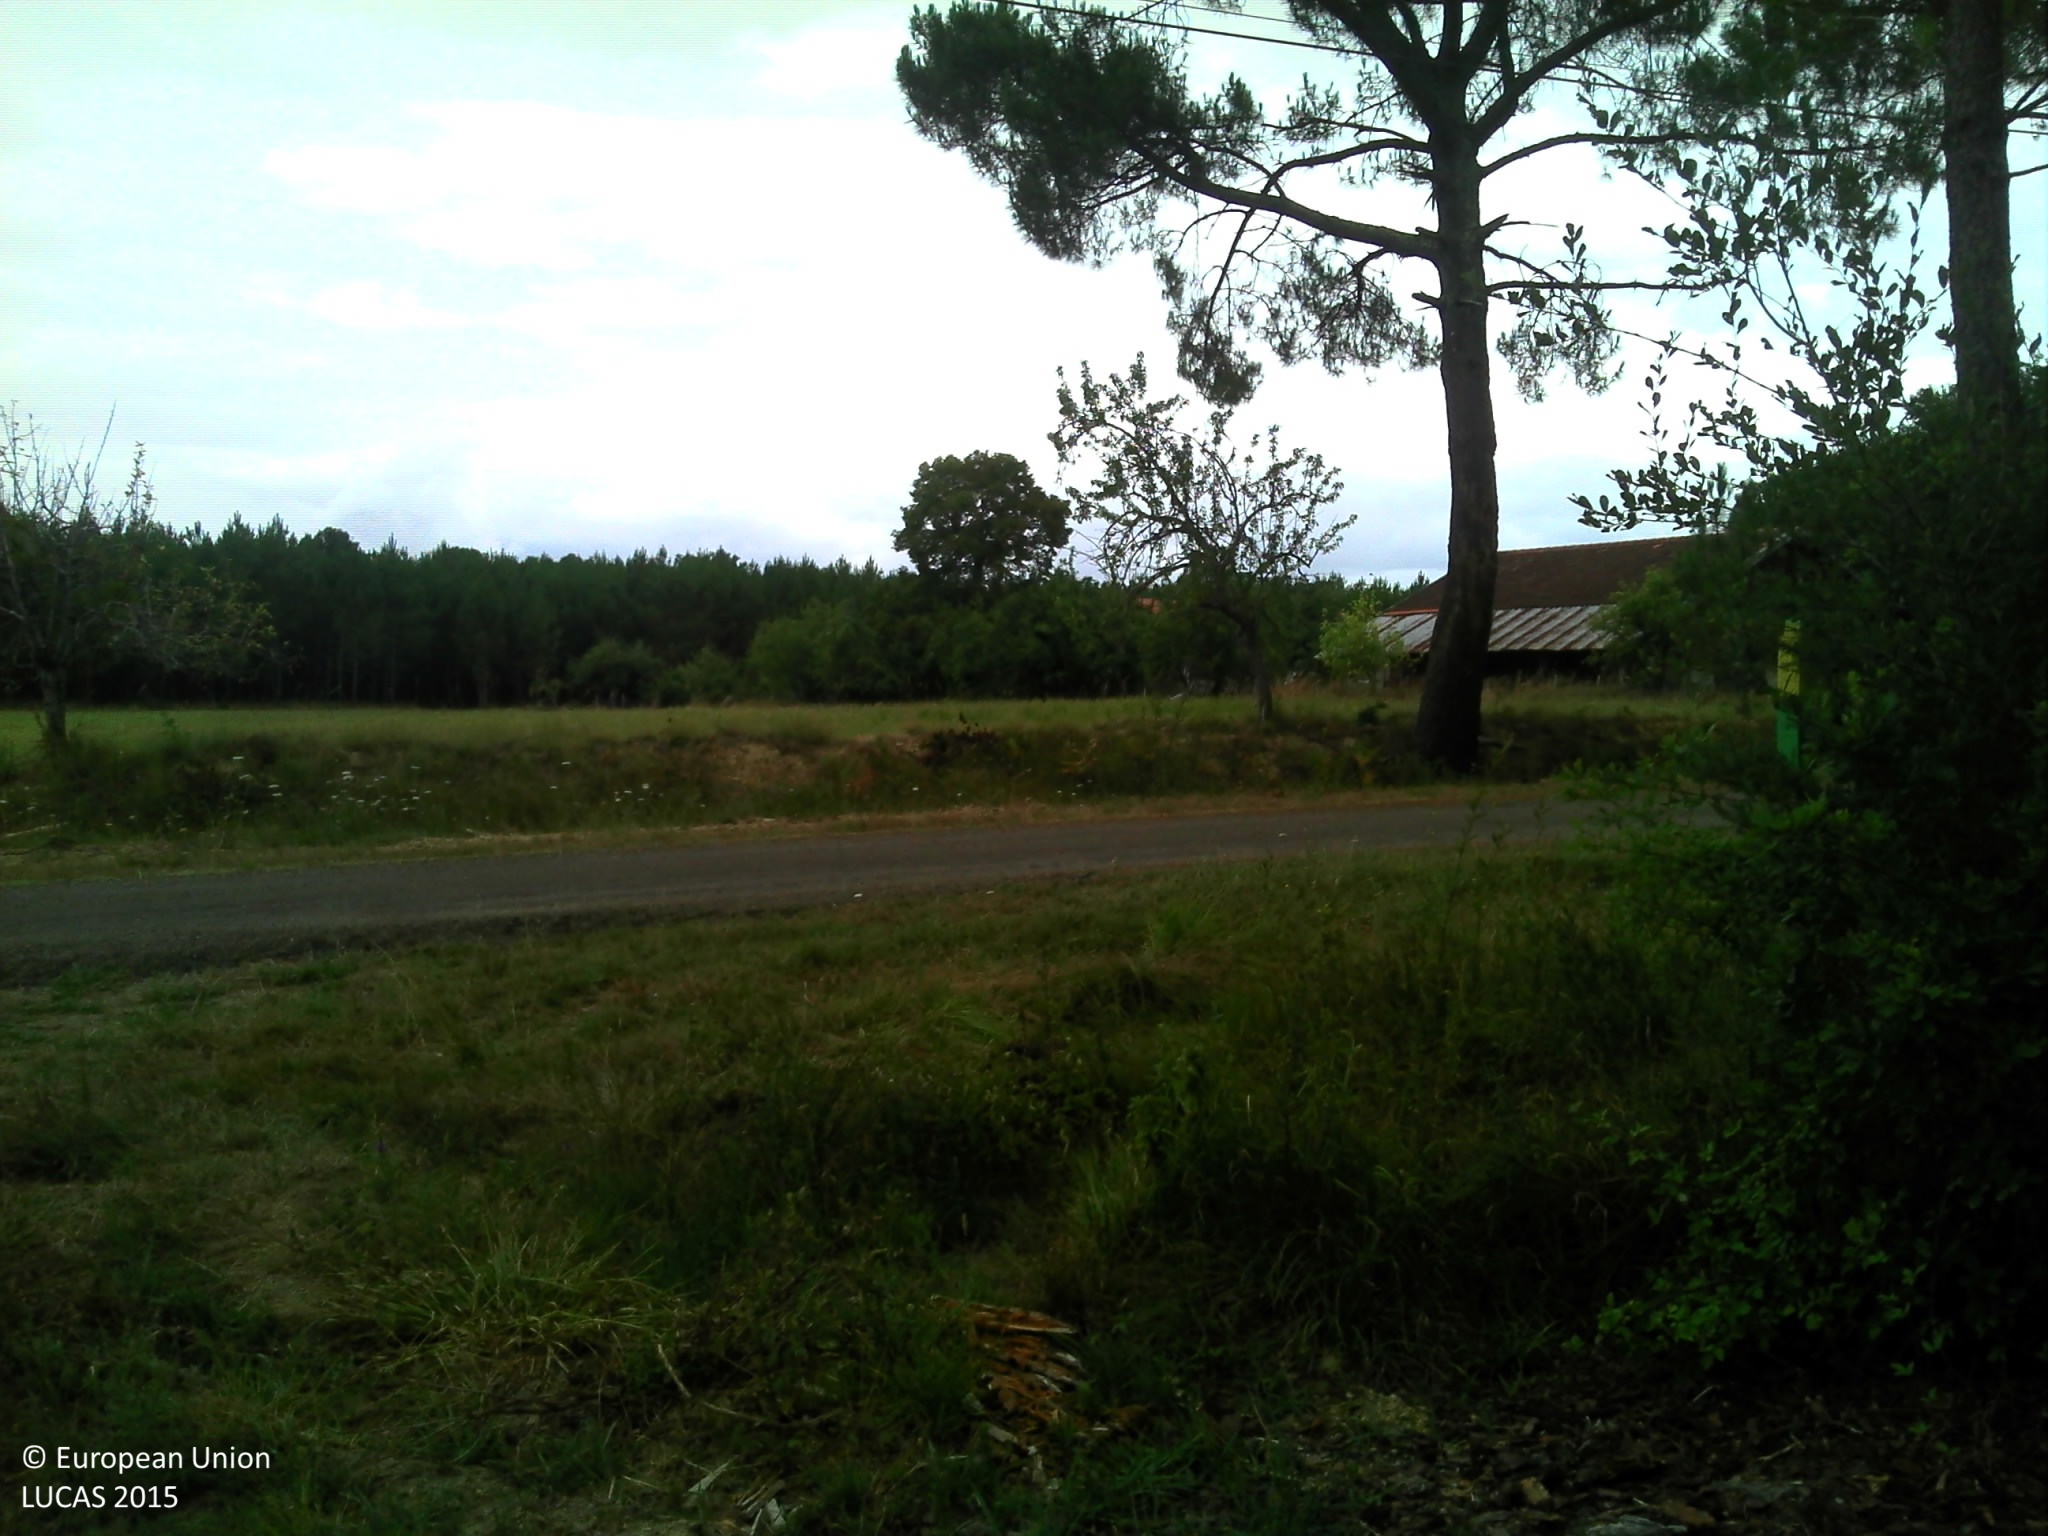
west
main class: Woodland
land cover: Pine dominated coniferous woodland
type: coniferous forest of the mediterranean region
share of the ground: > 75 %
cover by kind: coniferous forest trees 75 %, herbaceous plants 20 %, shrubs 5 %
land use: Forestry
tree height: < 5 m
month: July
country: FR
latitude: 43.9292
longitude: -0.8144
